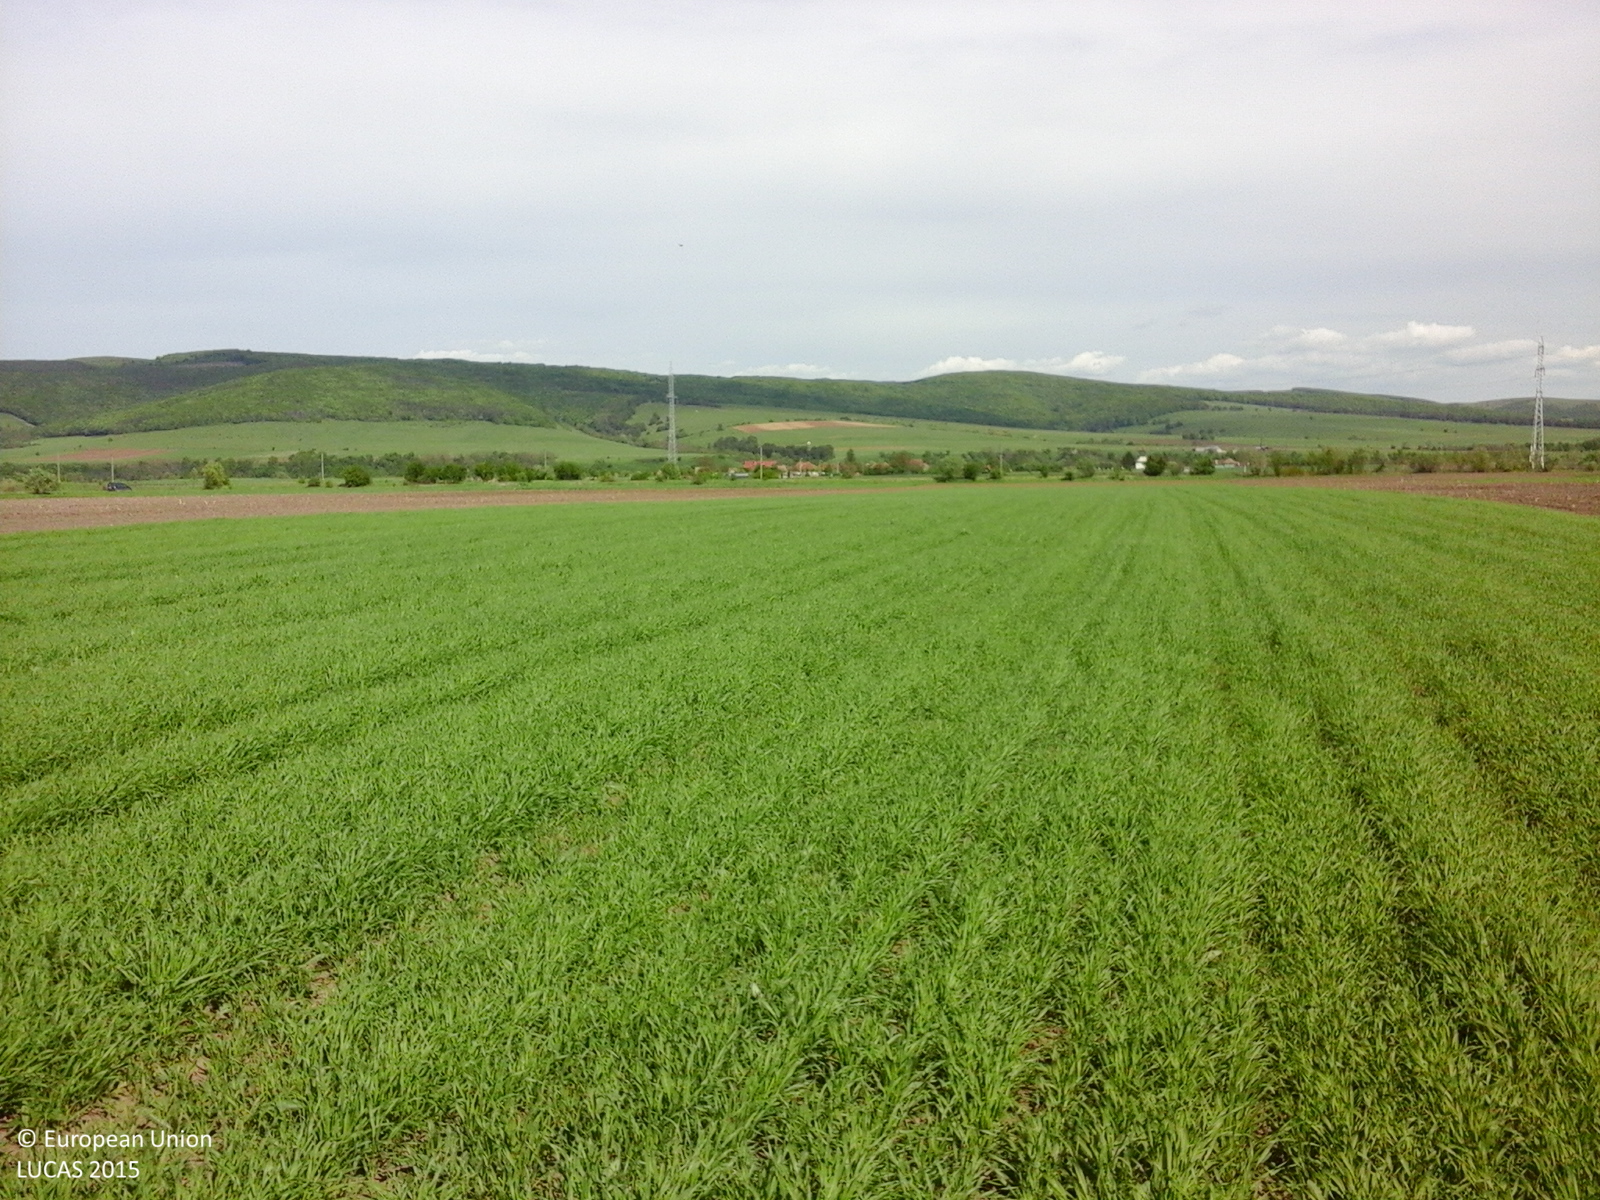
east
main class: Cropland
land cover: Common wheat
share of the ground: > 75 %
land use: Agriculture (excluding fallow land and kitchen gardens)
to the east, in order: Common wheat; Potatoes; Maize; Common wheat
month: May
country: RO
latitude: 45.9327
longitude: 25.8336
